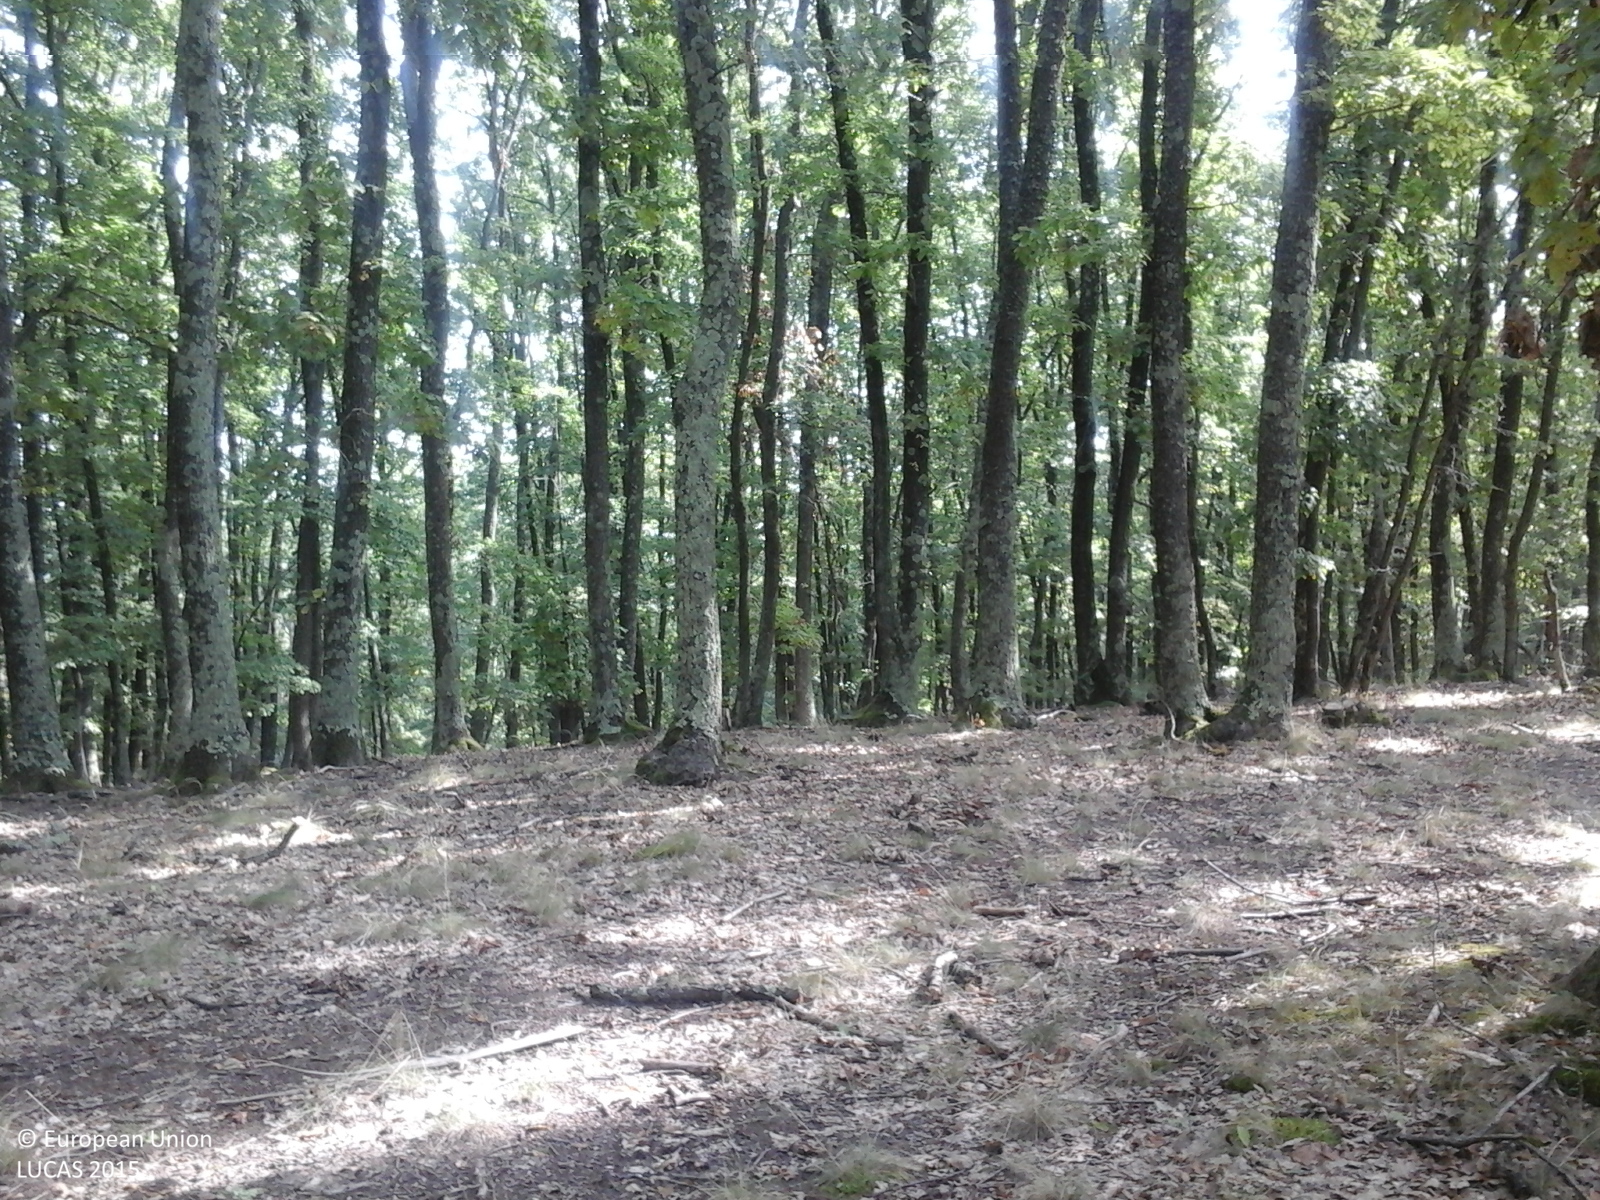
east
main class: Woodland
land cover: Broadleaved woodland
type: acidophilous oak and oak-birch forest
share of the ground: > 75 %
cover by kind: broadleaved forest trees 100 %
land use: Forestry
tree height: > 5 m
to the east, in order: Broadleaved woodland
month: September
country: RO
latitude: 46.9861
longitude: 23.0663
